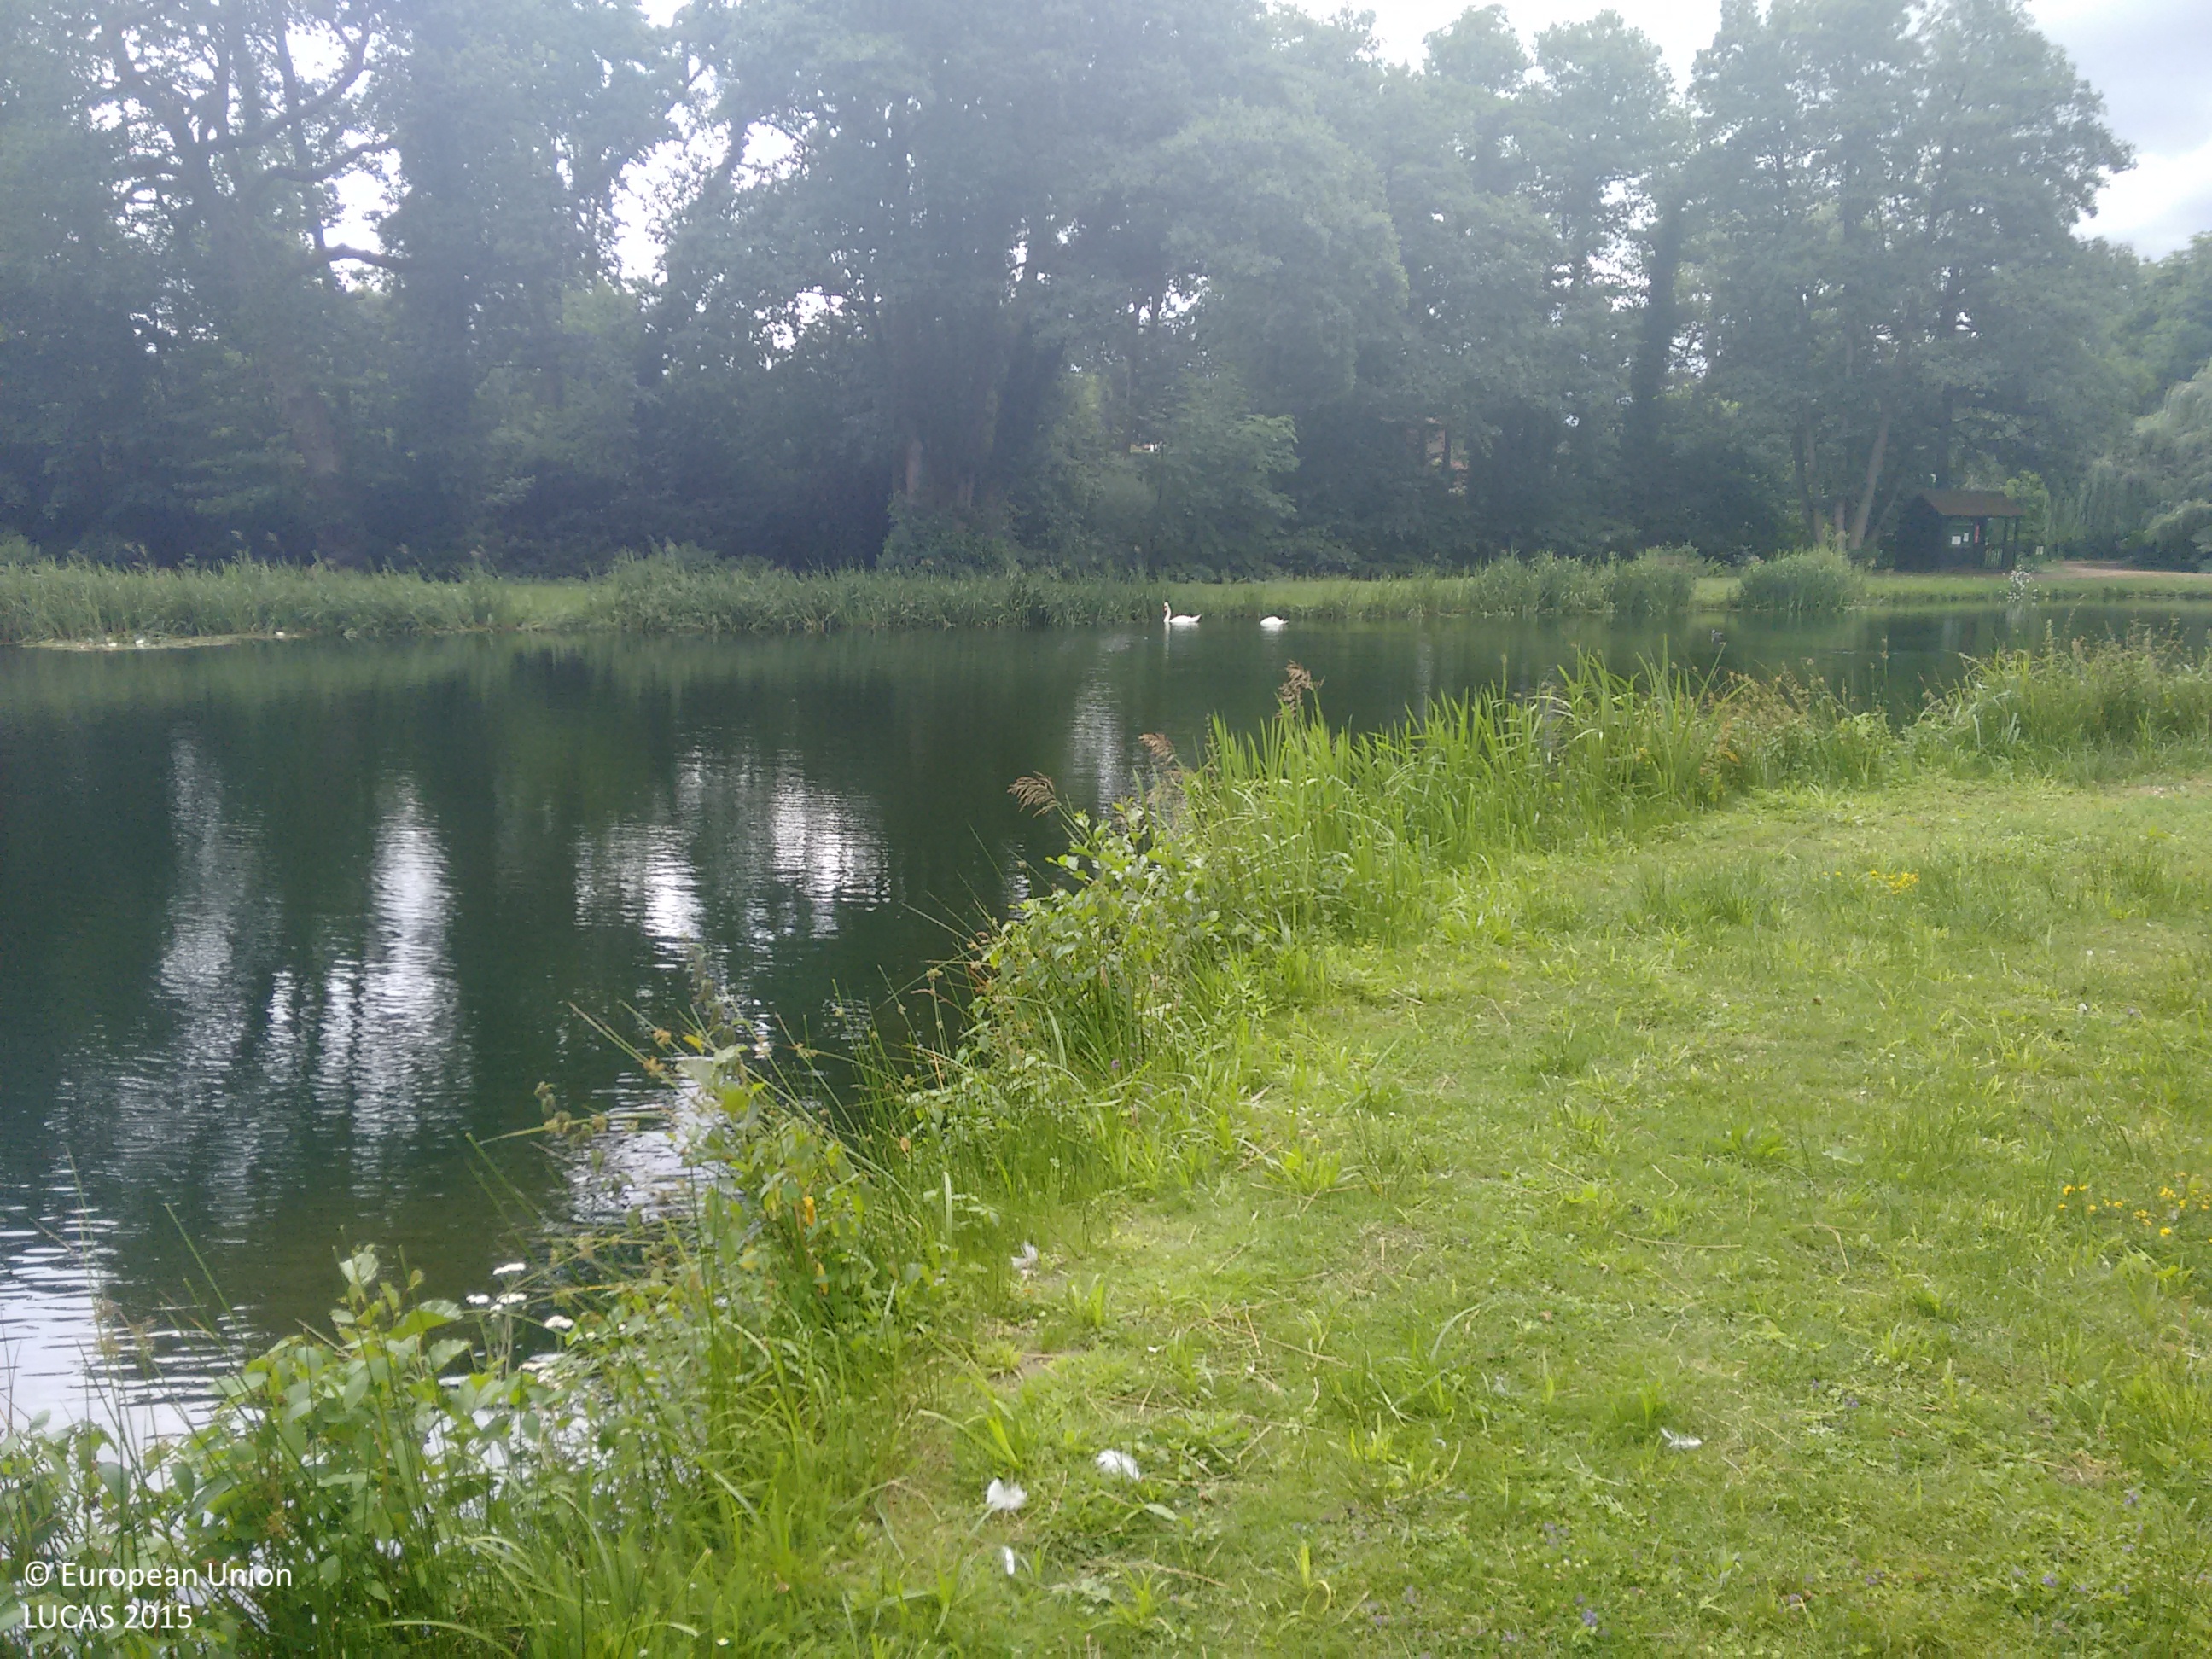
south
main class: Grassland
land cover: Grassland without tree/shrub cover
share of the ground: > 75 %
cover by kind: herbaceous plants 80 %, unconsolidated bare surface 20 %
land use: Sport
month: July
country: GB
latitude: 51.2184
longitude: -0.5333
